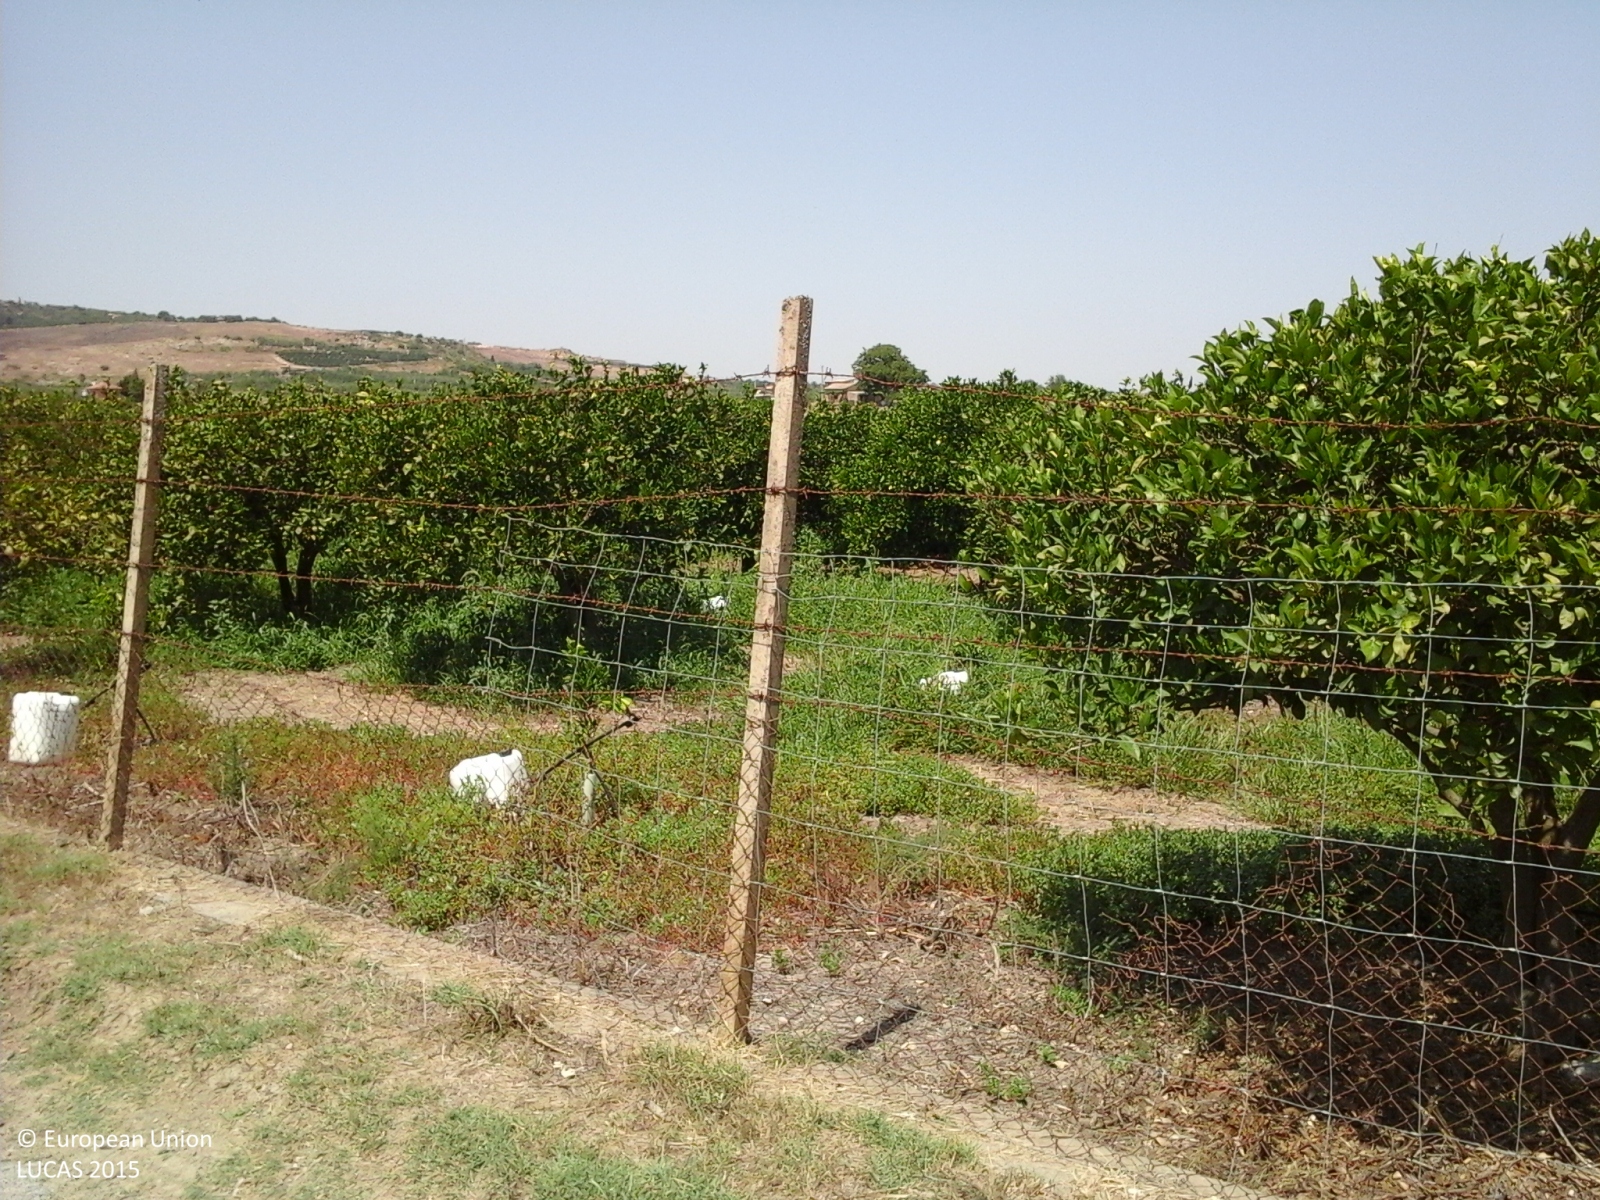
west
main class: Cropland
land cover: Oranges
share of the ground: > 75 %
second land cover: Spontaneously vegetated surfaces
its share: > 75 %
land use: Agriculture (excluding fallow land and kitchen gardens)
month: August
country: IT
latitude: 37.3146
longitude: 14.8497
